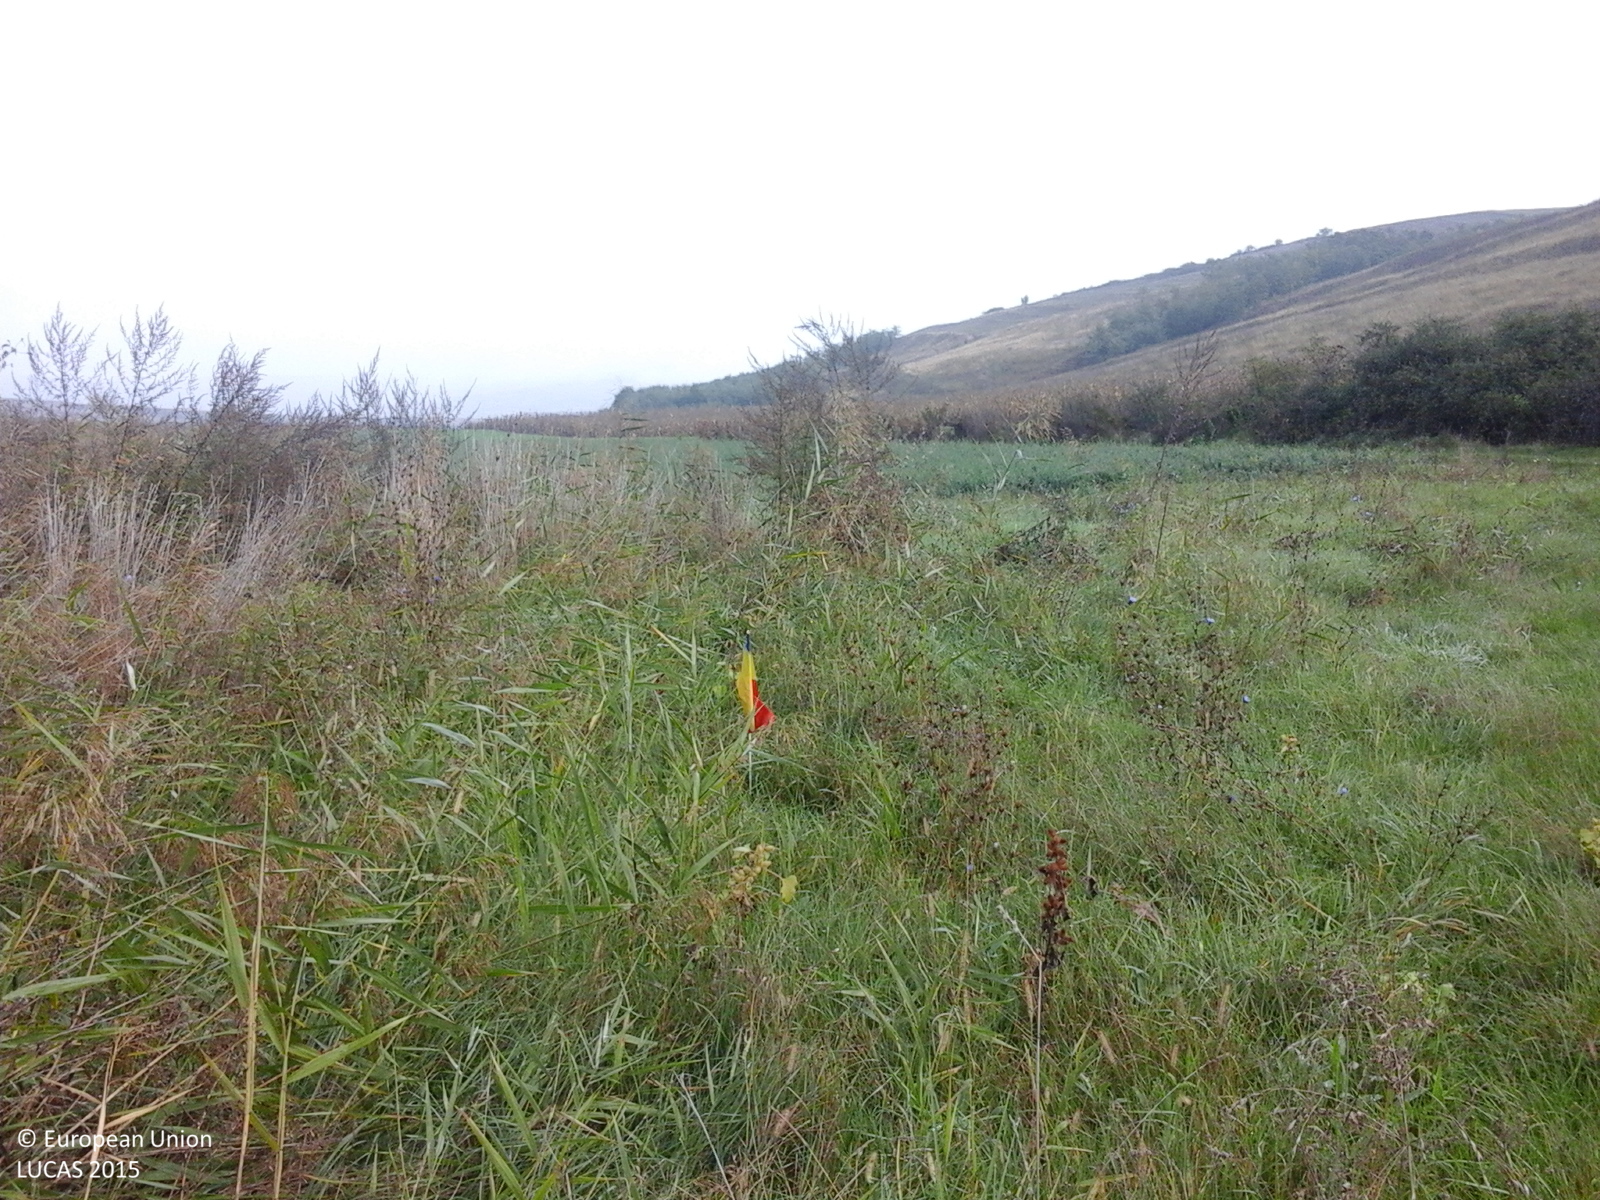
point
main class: Grassland
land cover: Spontaneously vegetated surfaces
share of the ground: > 75 %
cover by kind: herbaceous plants 100 %
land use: Agriculture (excluding fallow land and kitchen gardens)
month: October
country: RO
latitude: 46.0186
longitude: 23.9320
